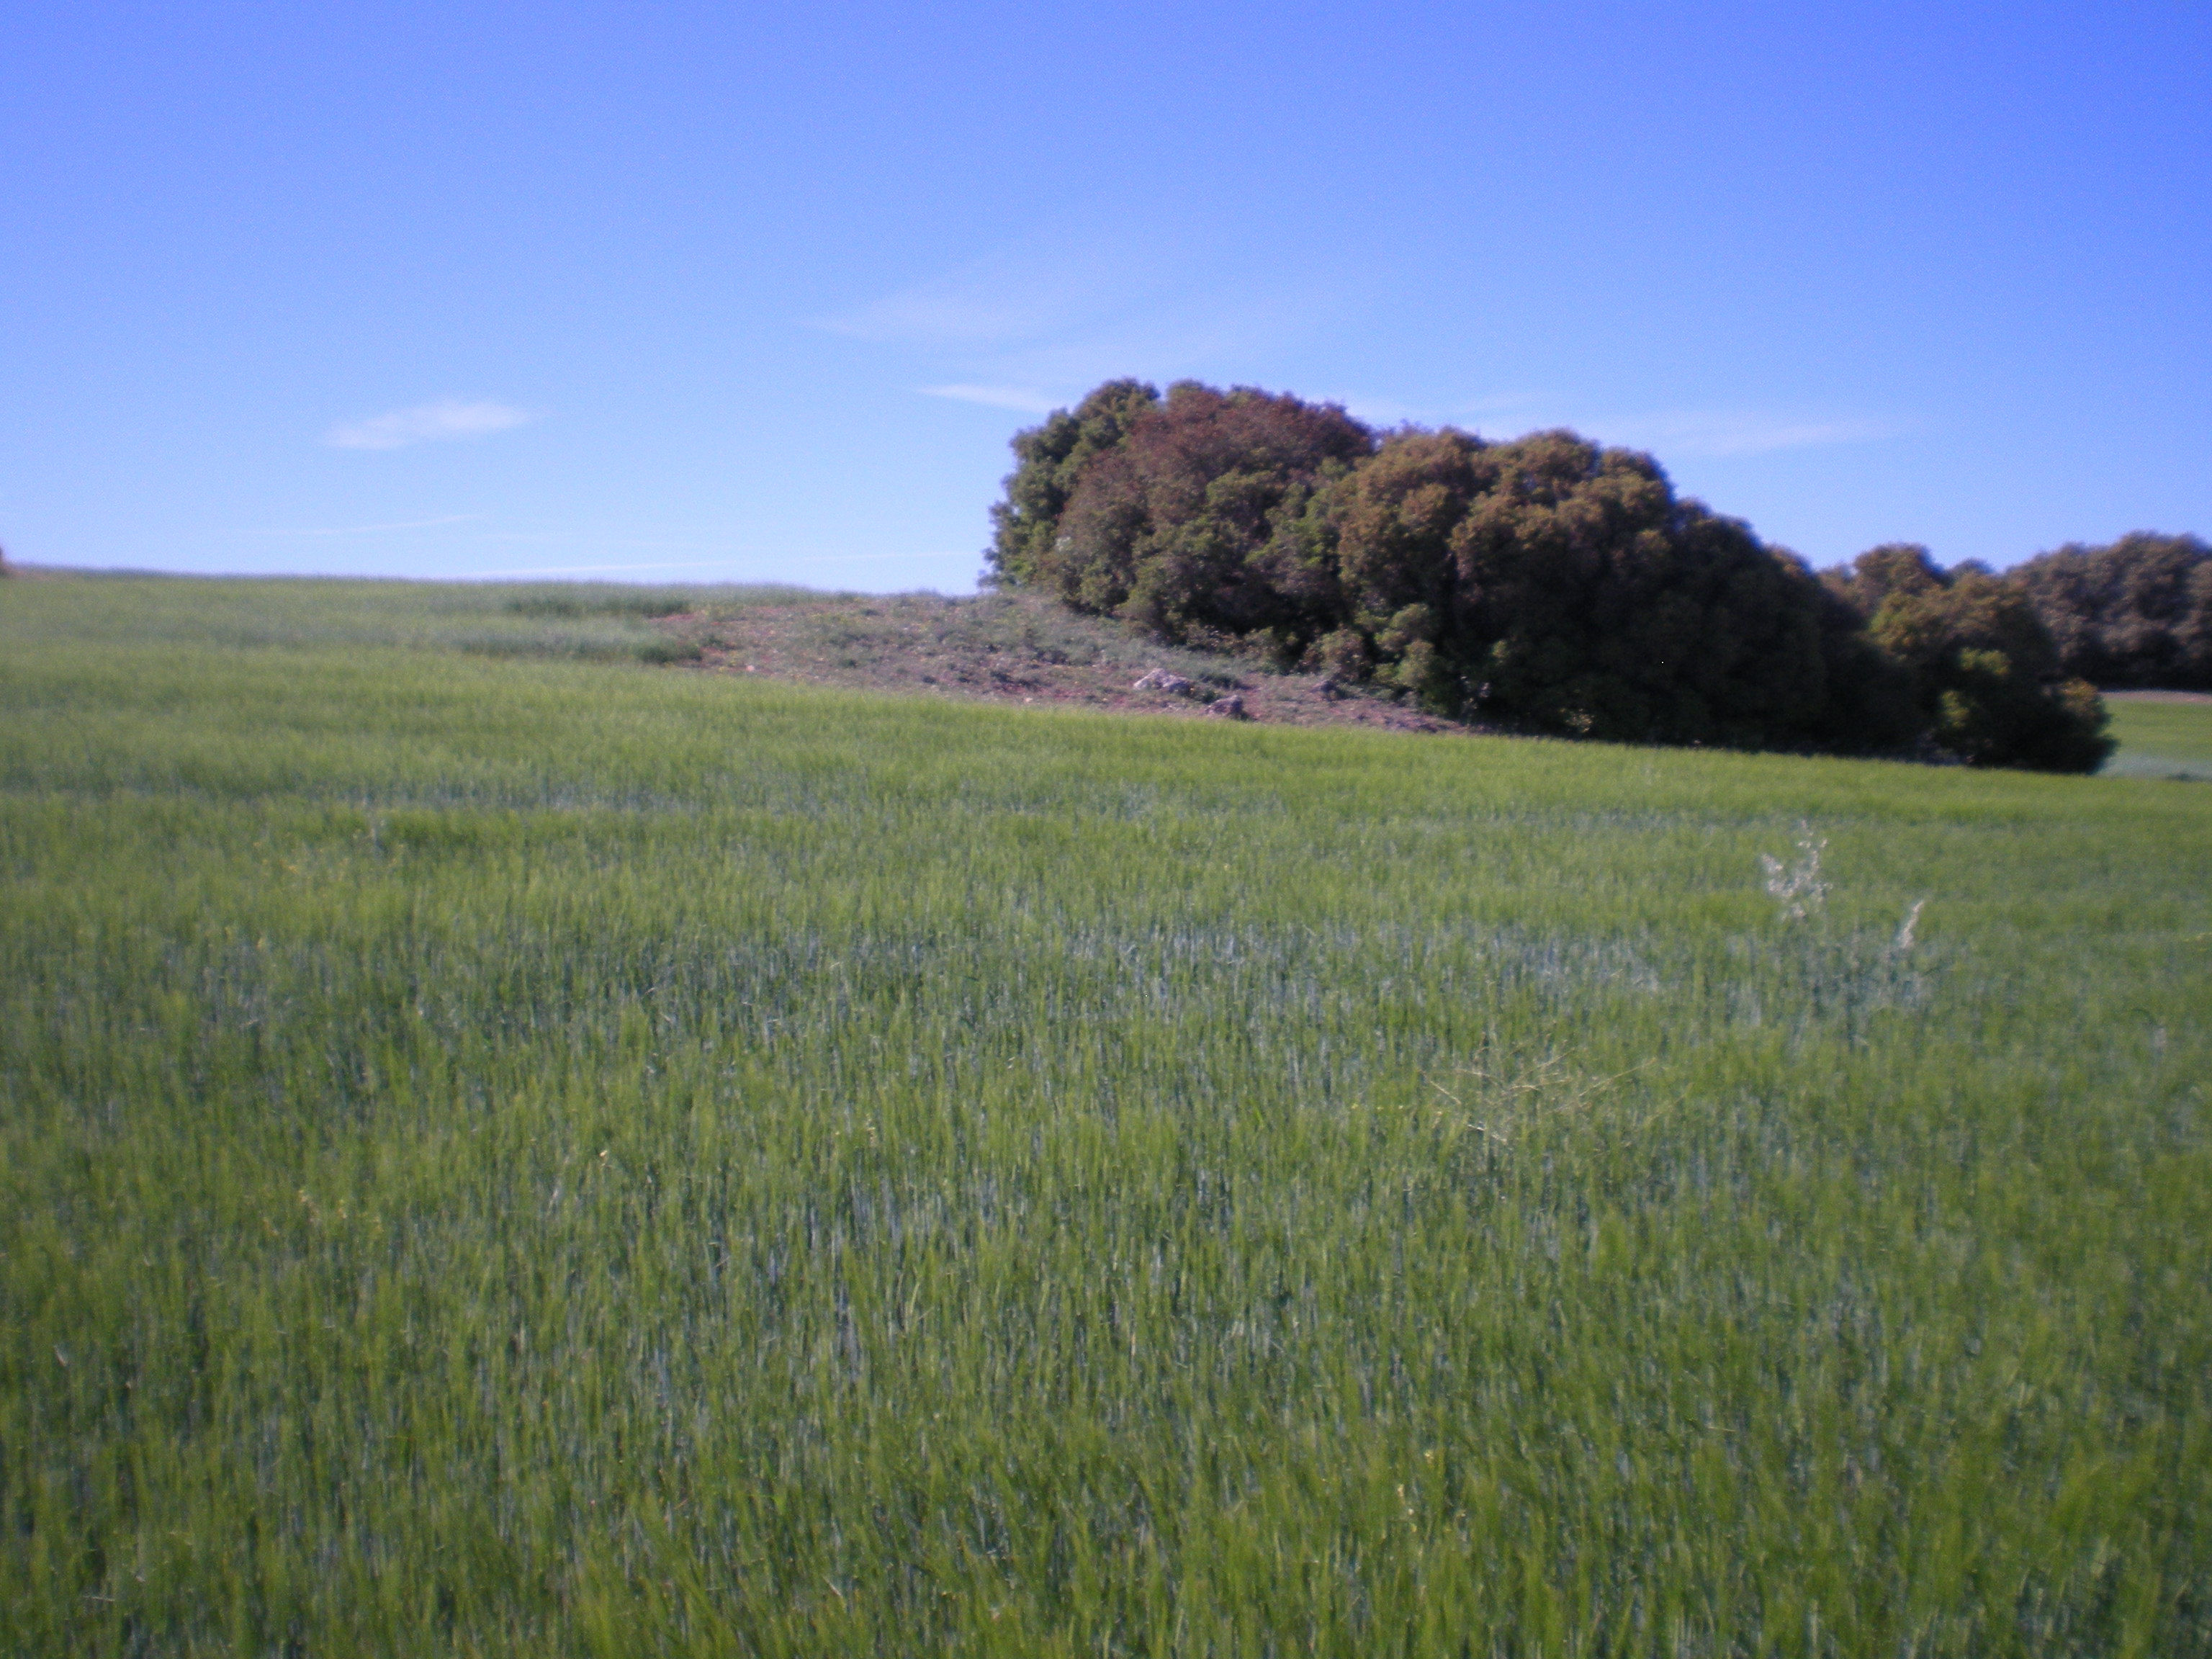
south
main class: Cropland
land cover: Barley
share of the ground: > 75 %
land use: Agriculture (excluding fallow land and kitchen gardens)
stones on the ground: 10 - 25 %
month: May
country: ES
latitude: 38.9360
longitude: -3.0343
